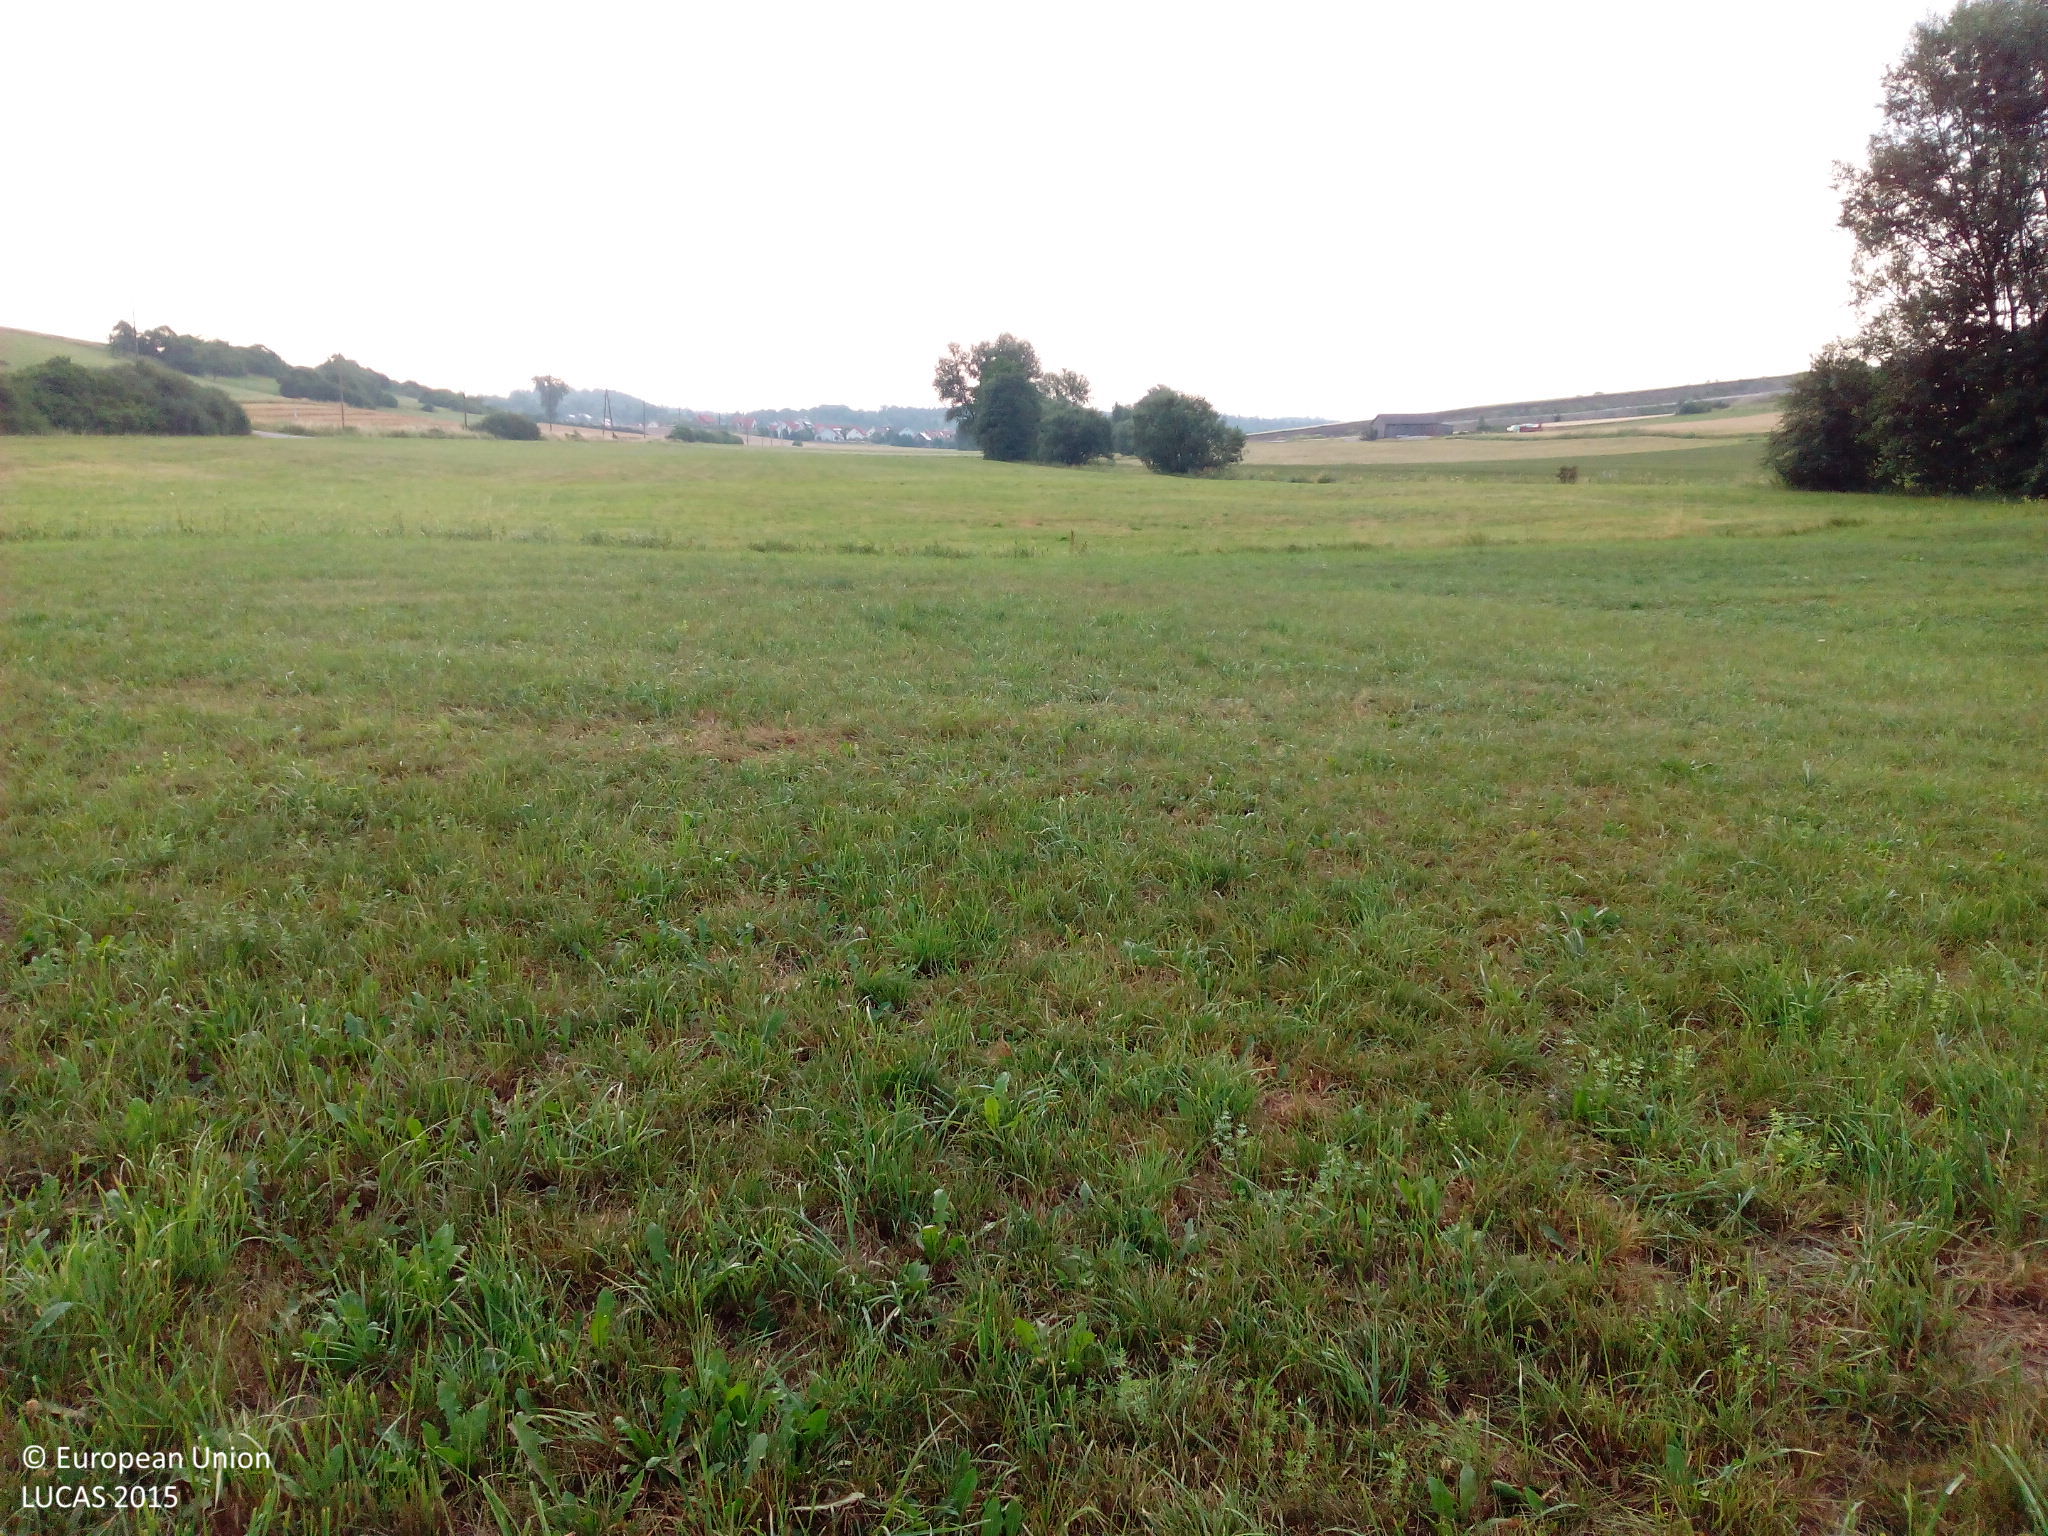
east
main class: Grassland
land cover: Grassland without tree/shrub cover
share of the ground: > 75 %
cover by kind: herbaceous plants 95 %, unconsolidated bare surface 5 %
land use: Agriculture (excluding fallow land and kitchen gardens)
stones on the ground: < 10 %
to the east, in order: Grassland without tree/shrub cover; Shruby margins; Ditches and canals; Shruby margins; Grassland without tree/shrub cover
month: July
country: DE
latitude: 49.1051
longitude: 9.9589
